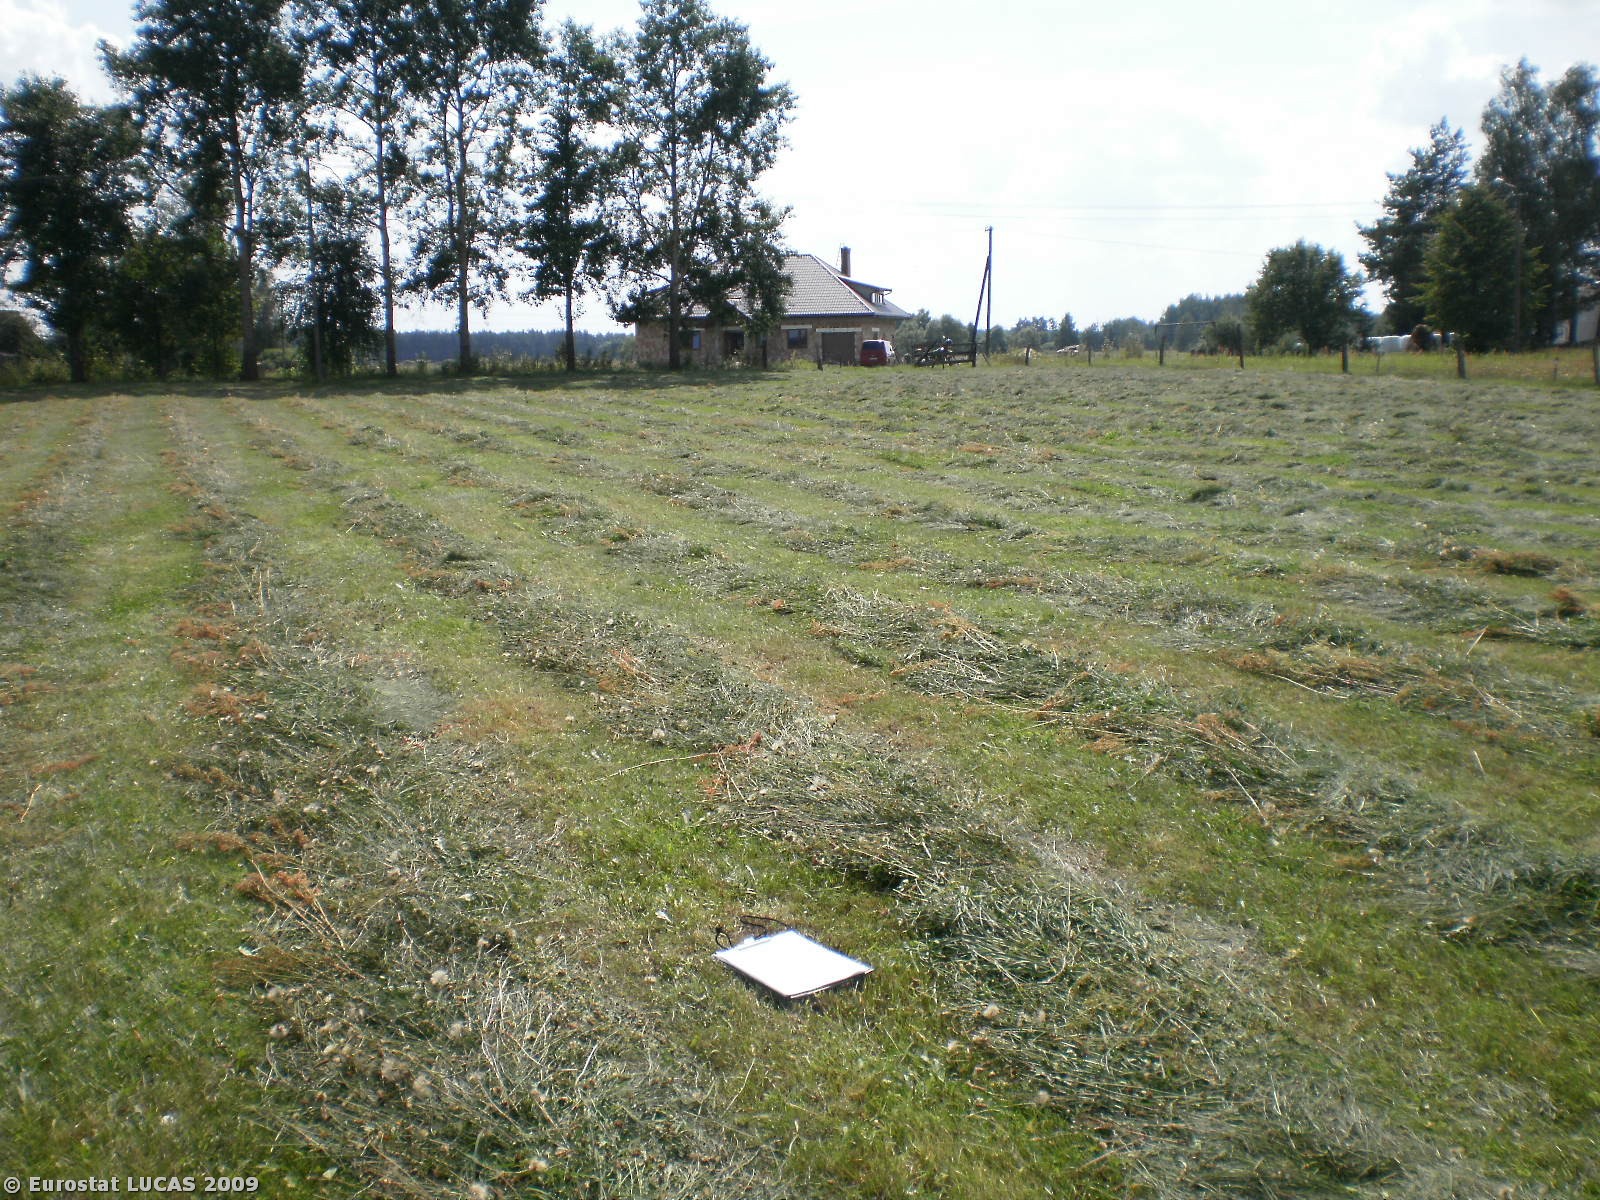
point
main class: Grassland
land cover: Grassland without tree/shrub cover
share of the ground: > 75 %
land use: Agriculture (excluding fallow land and kitchen gardens)
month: July
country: PL
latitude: 53.3967
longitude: 21.3117
